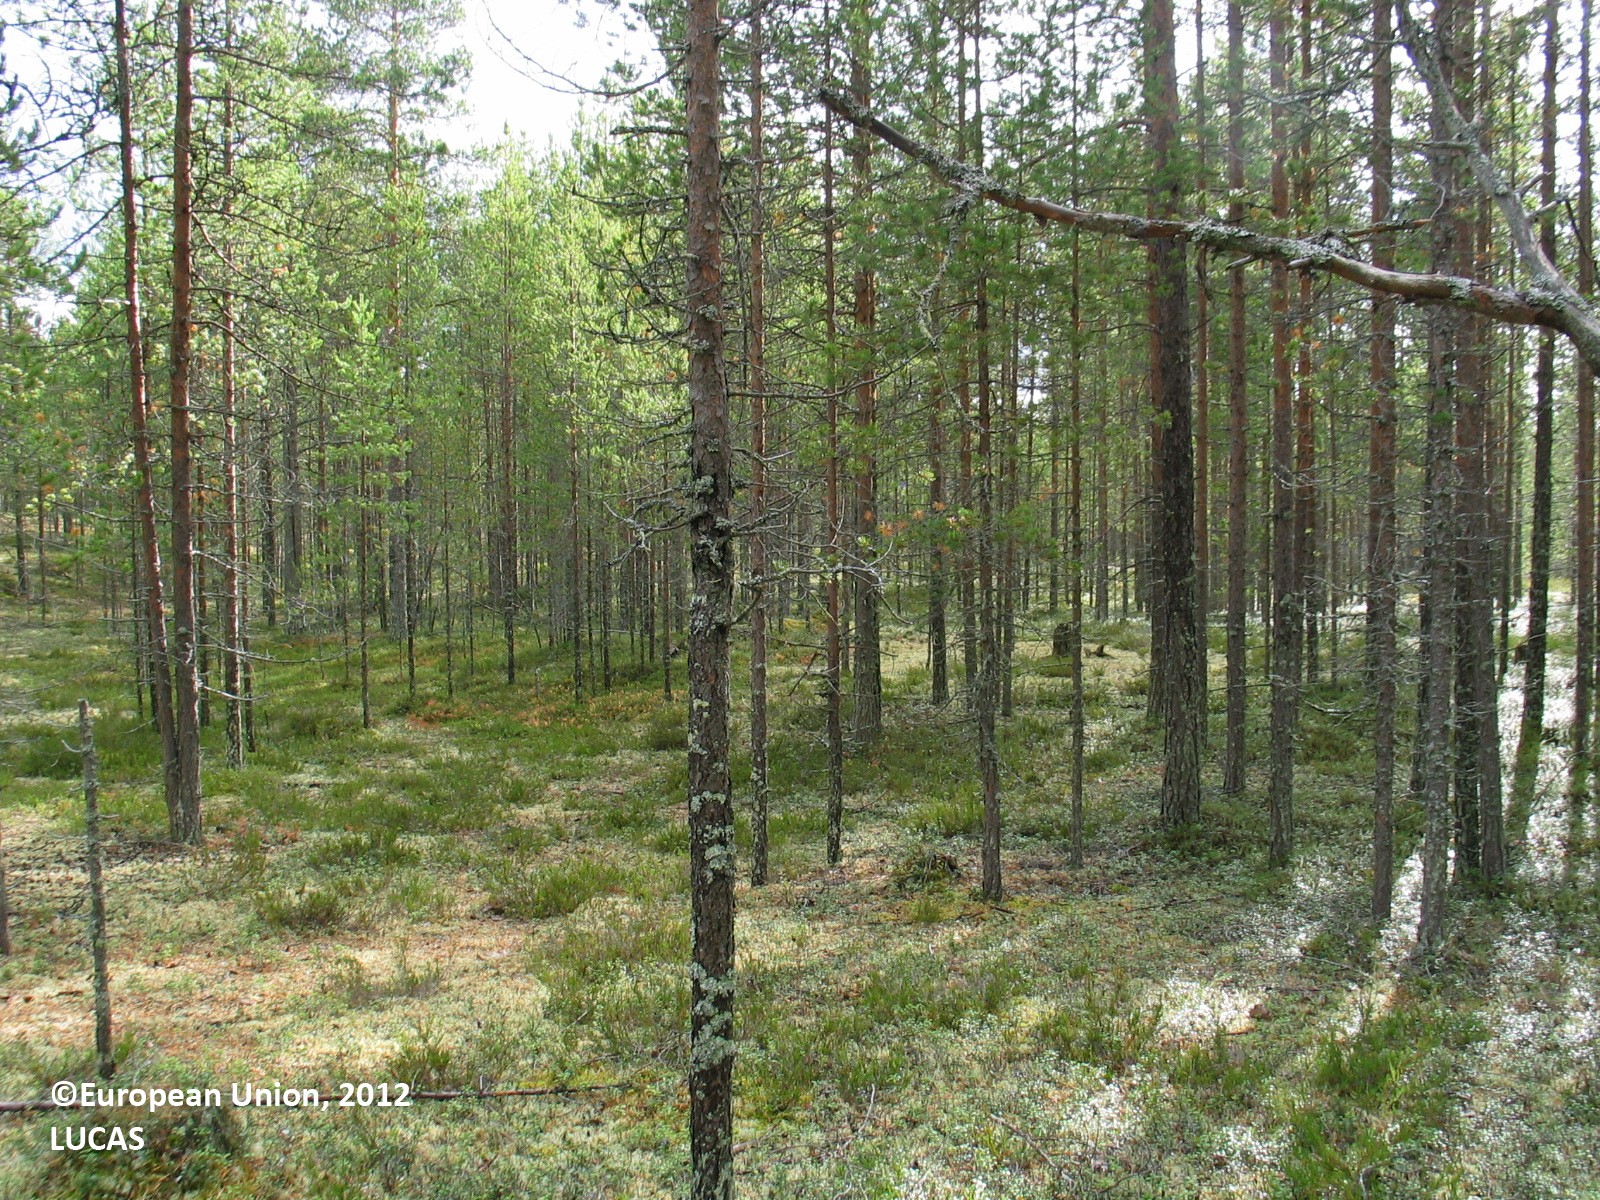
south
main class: Woodland
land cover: Pine dominated coniferous woodland
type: boreal forest
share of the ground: 25 - 50 %
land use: Forestry
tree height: > 5 m
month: September
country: FI
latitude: 65.4175
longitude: 25.5697
